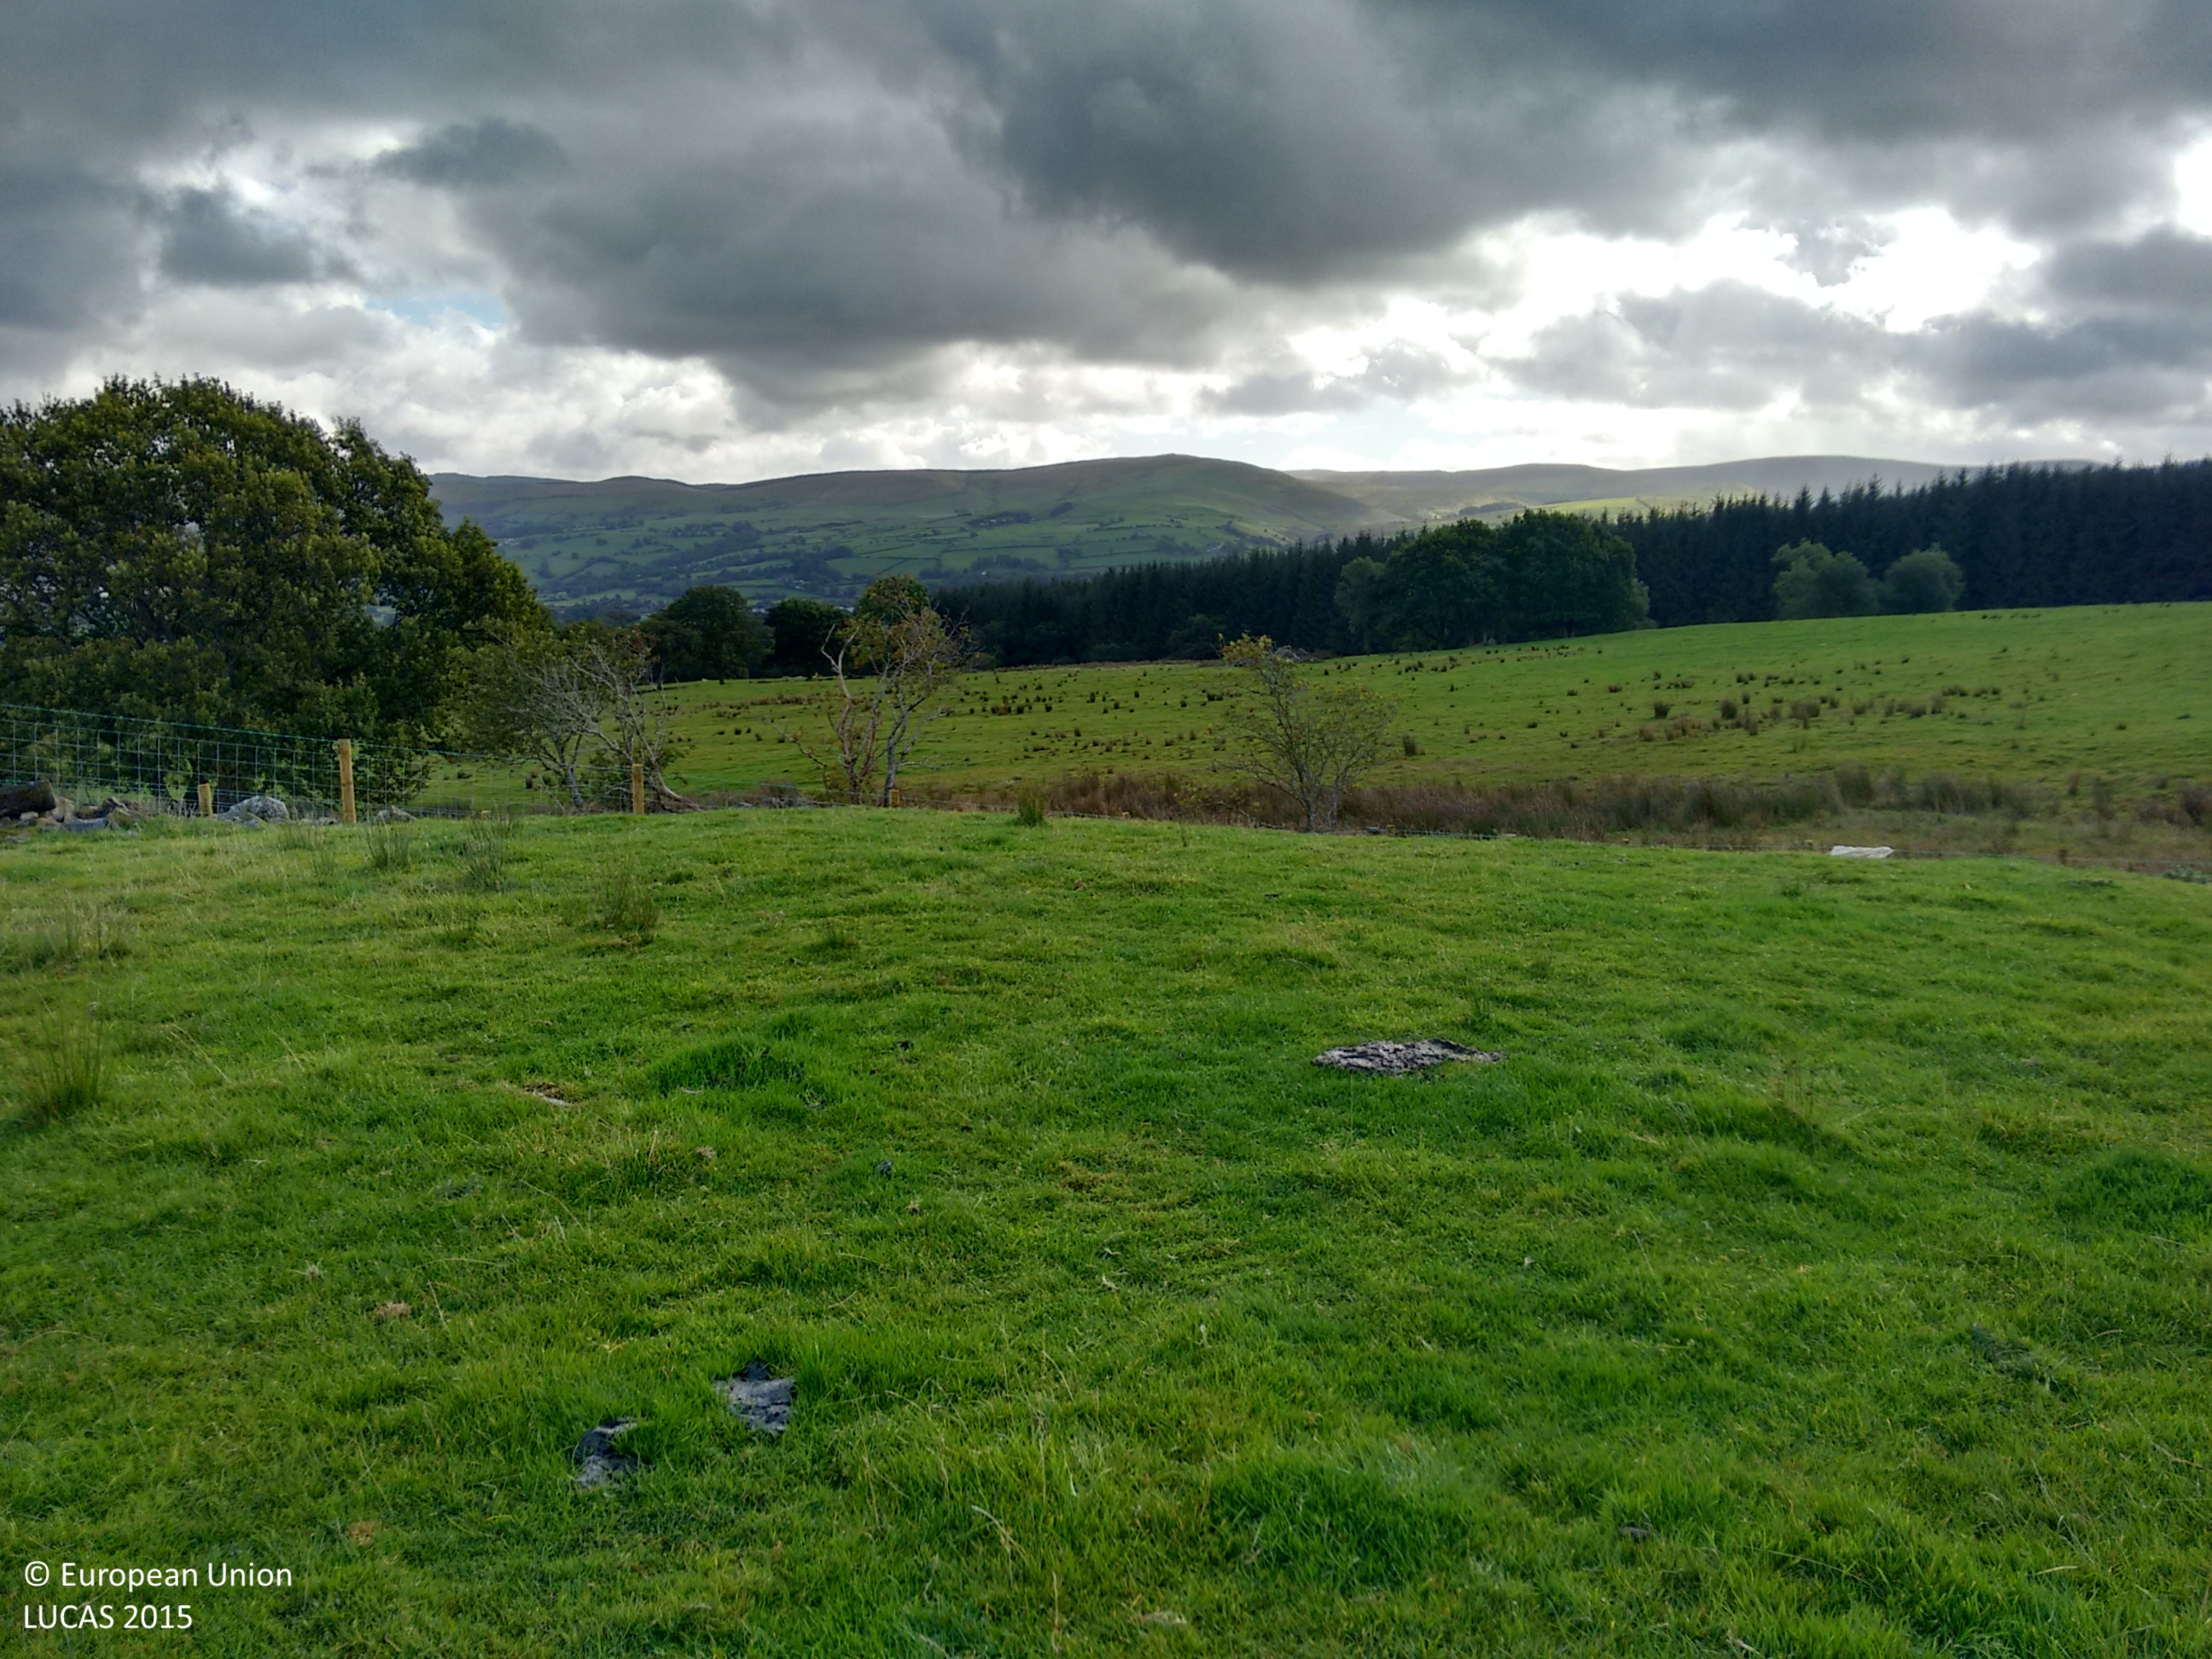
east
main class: Grassland
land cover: Grassland without tree/shrub cover
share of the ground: > 75 %
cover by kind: herbaceous plants 100 %
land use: Agriculture (excluding fallow land and kitchen gardens)
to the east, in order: Grassland without tree/shrub cover; Fences; Grass margins; Fences; Grassland without tree/shrub cover; Lines of trees; Grassland without tree/shrub cover
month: September
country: GB
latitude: 52.8548
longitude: -3.7065
